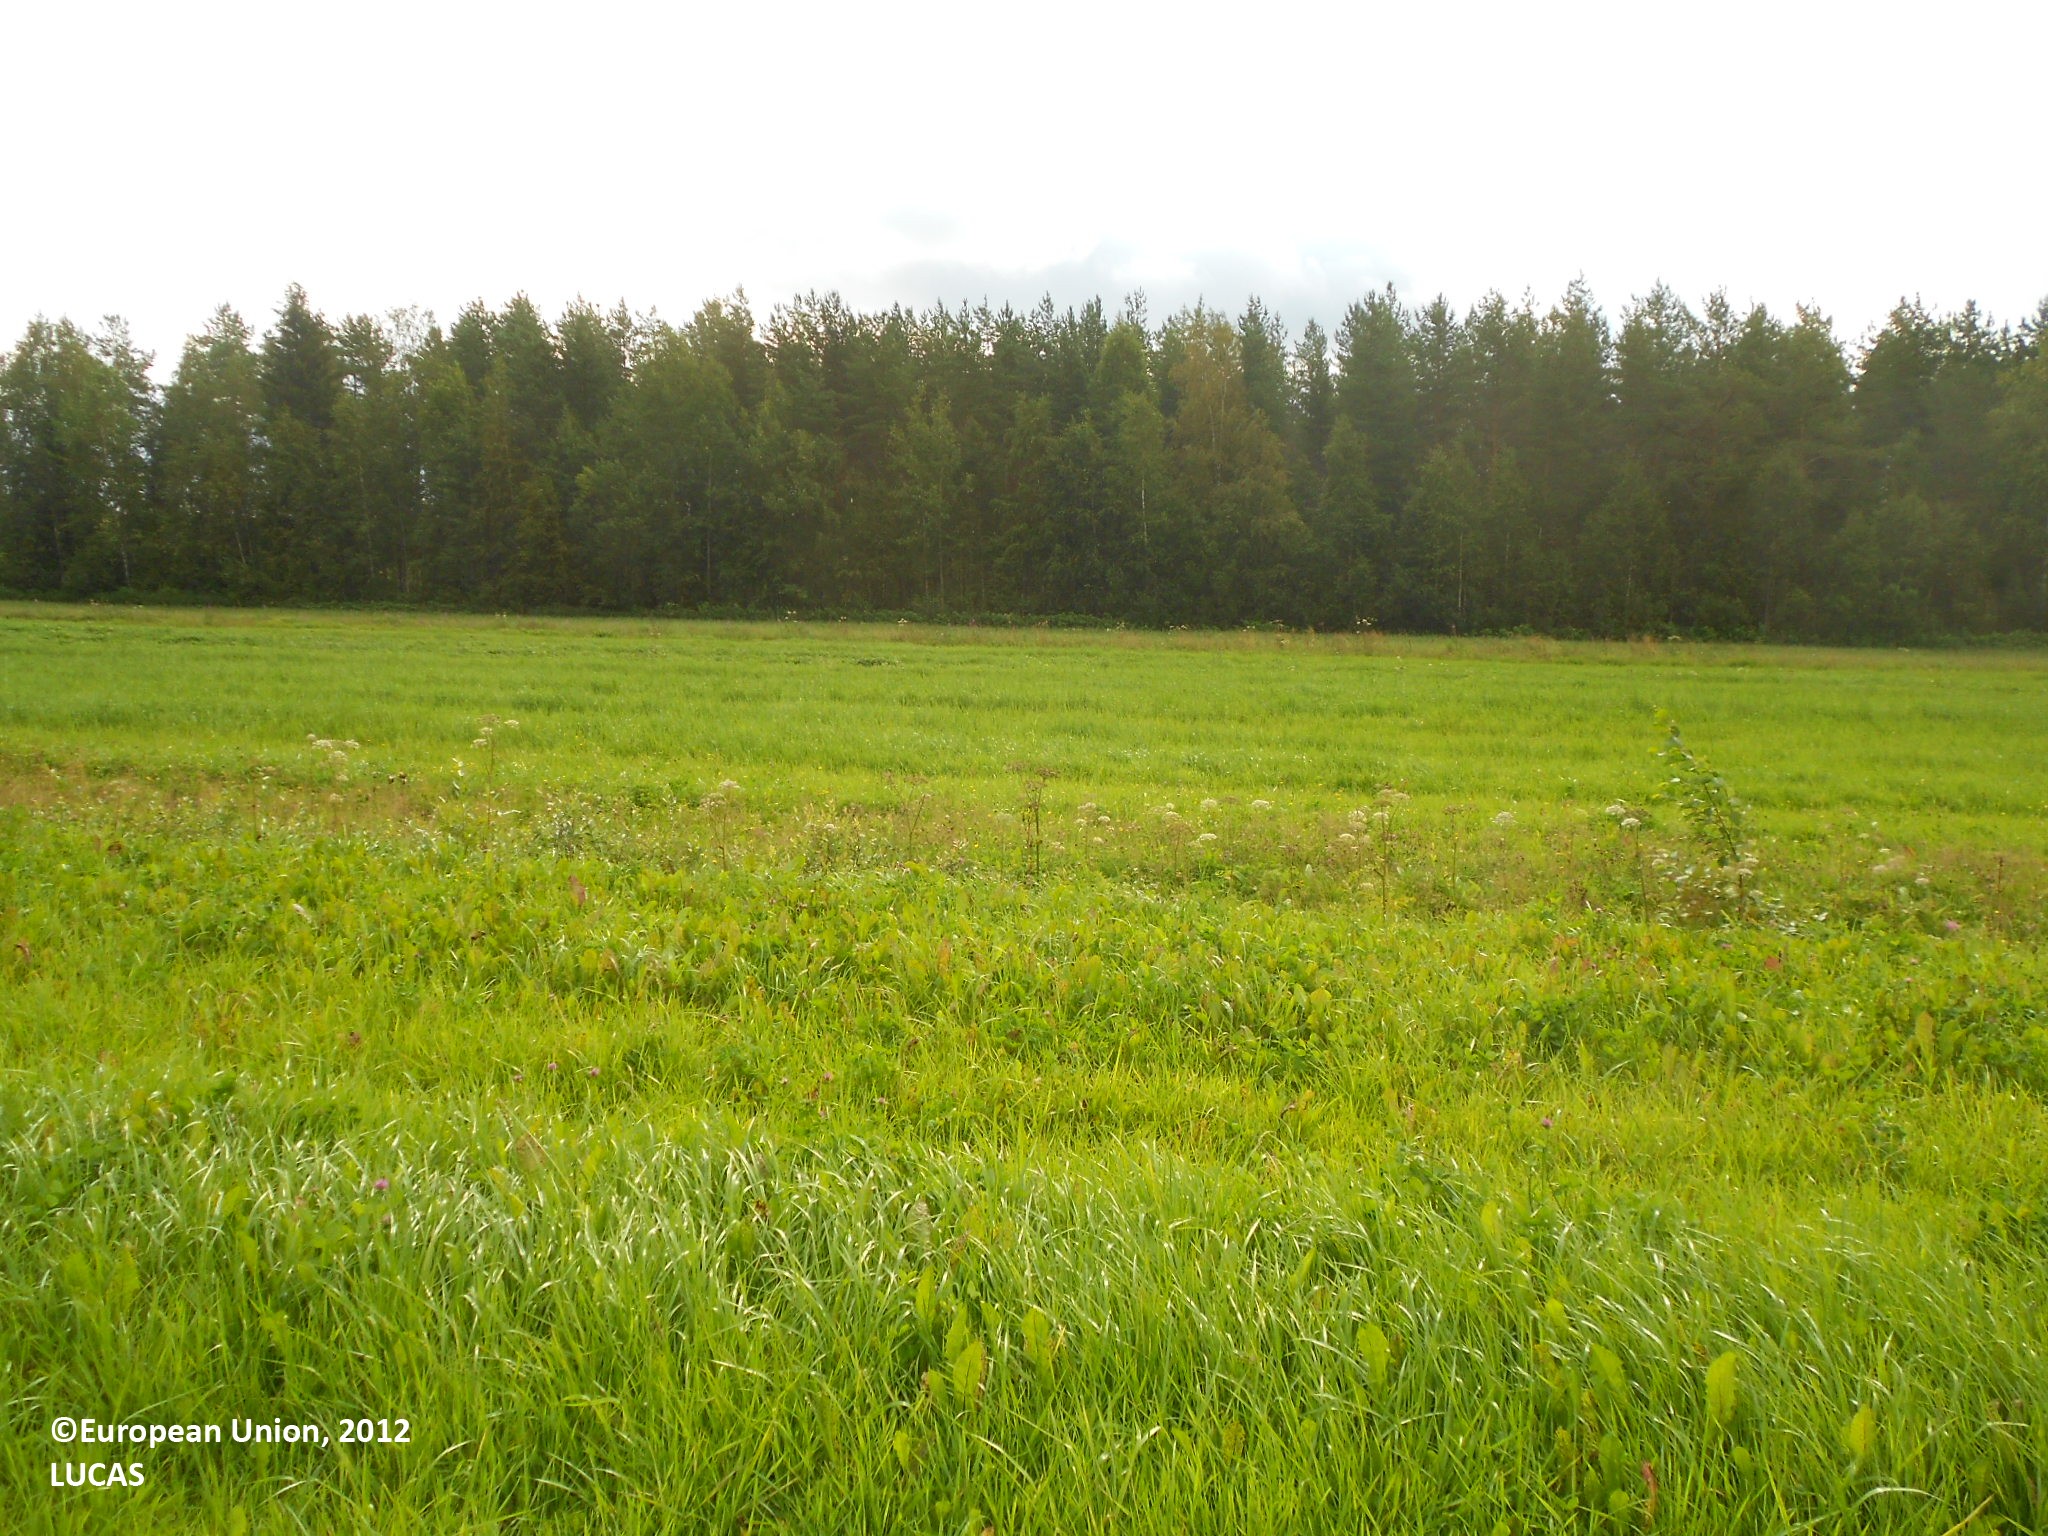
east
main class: Cropland
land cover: Temporary grasslands
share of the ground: > 75 %
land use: Agriculture (excluding fallow land and kitchen gardens)
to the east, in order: Temporary grasslands; Grassland without tree/shrub cover; Ditches and canals; Grassland without tree/shrub cover; Ditches and canals; Grassland without tree/shrub cover; Tracks; Grass margins; Ditches and canals; Common wheat; Ditches and canals; Pine dominated mixed woodland; Ditches and canals; Pine dominated mixed woodland; Ditches and canals; Common wheat; Ditches and canals; Common wheat
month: August
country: FI
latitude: 63.7035
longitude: 28.6642
